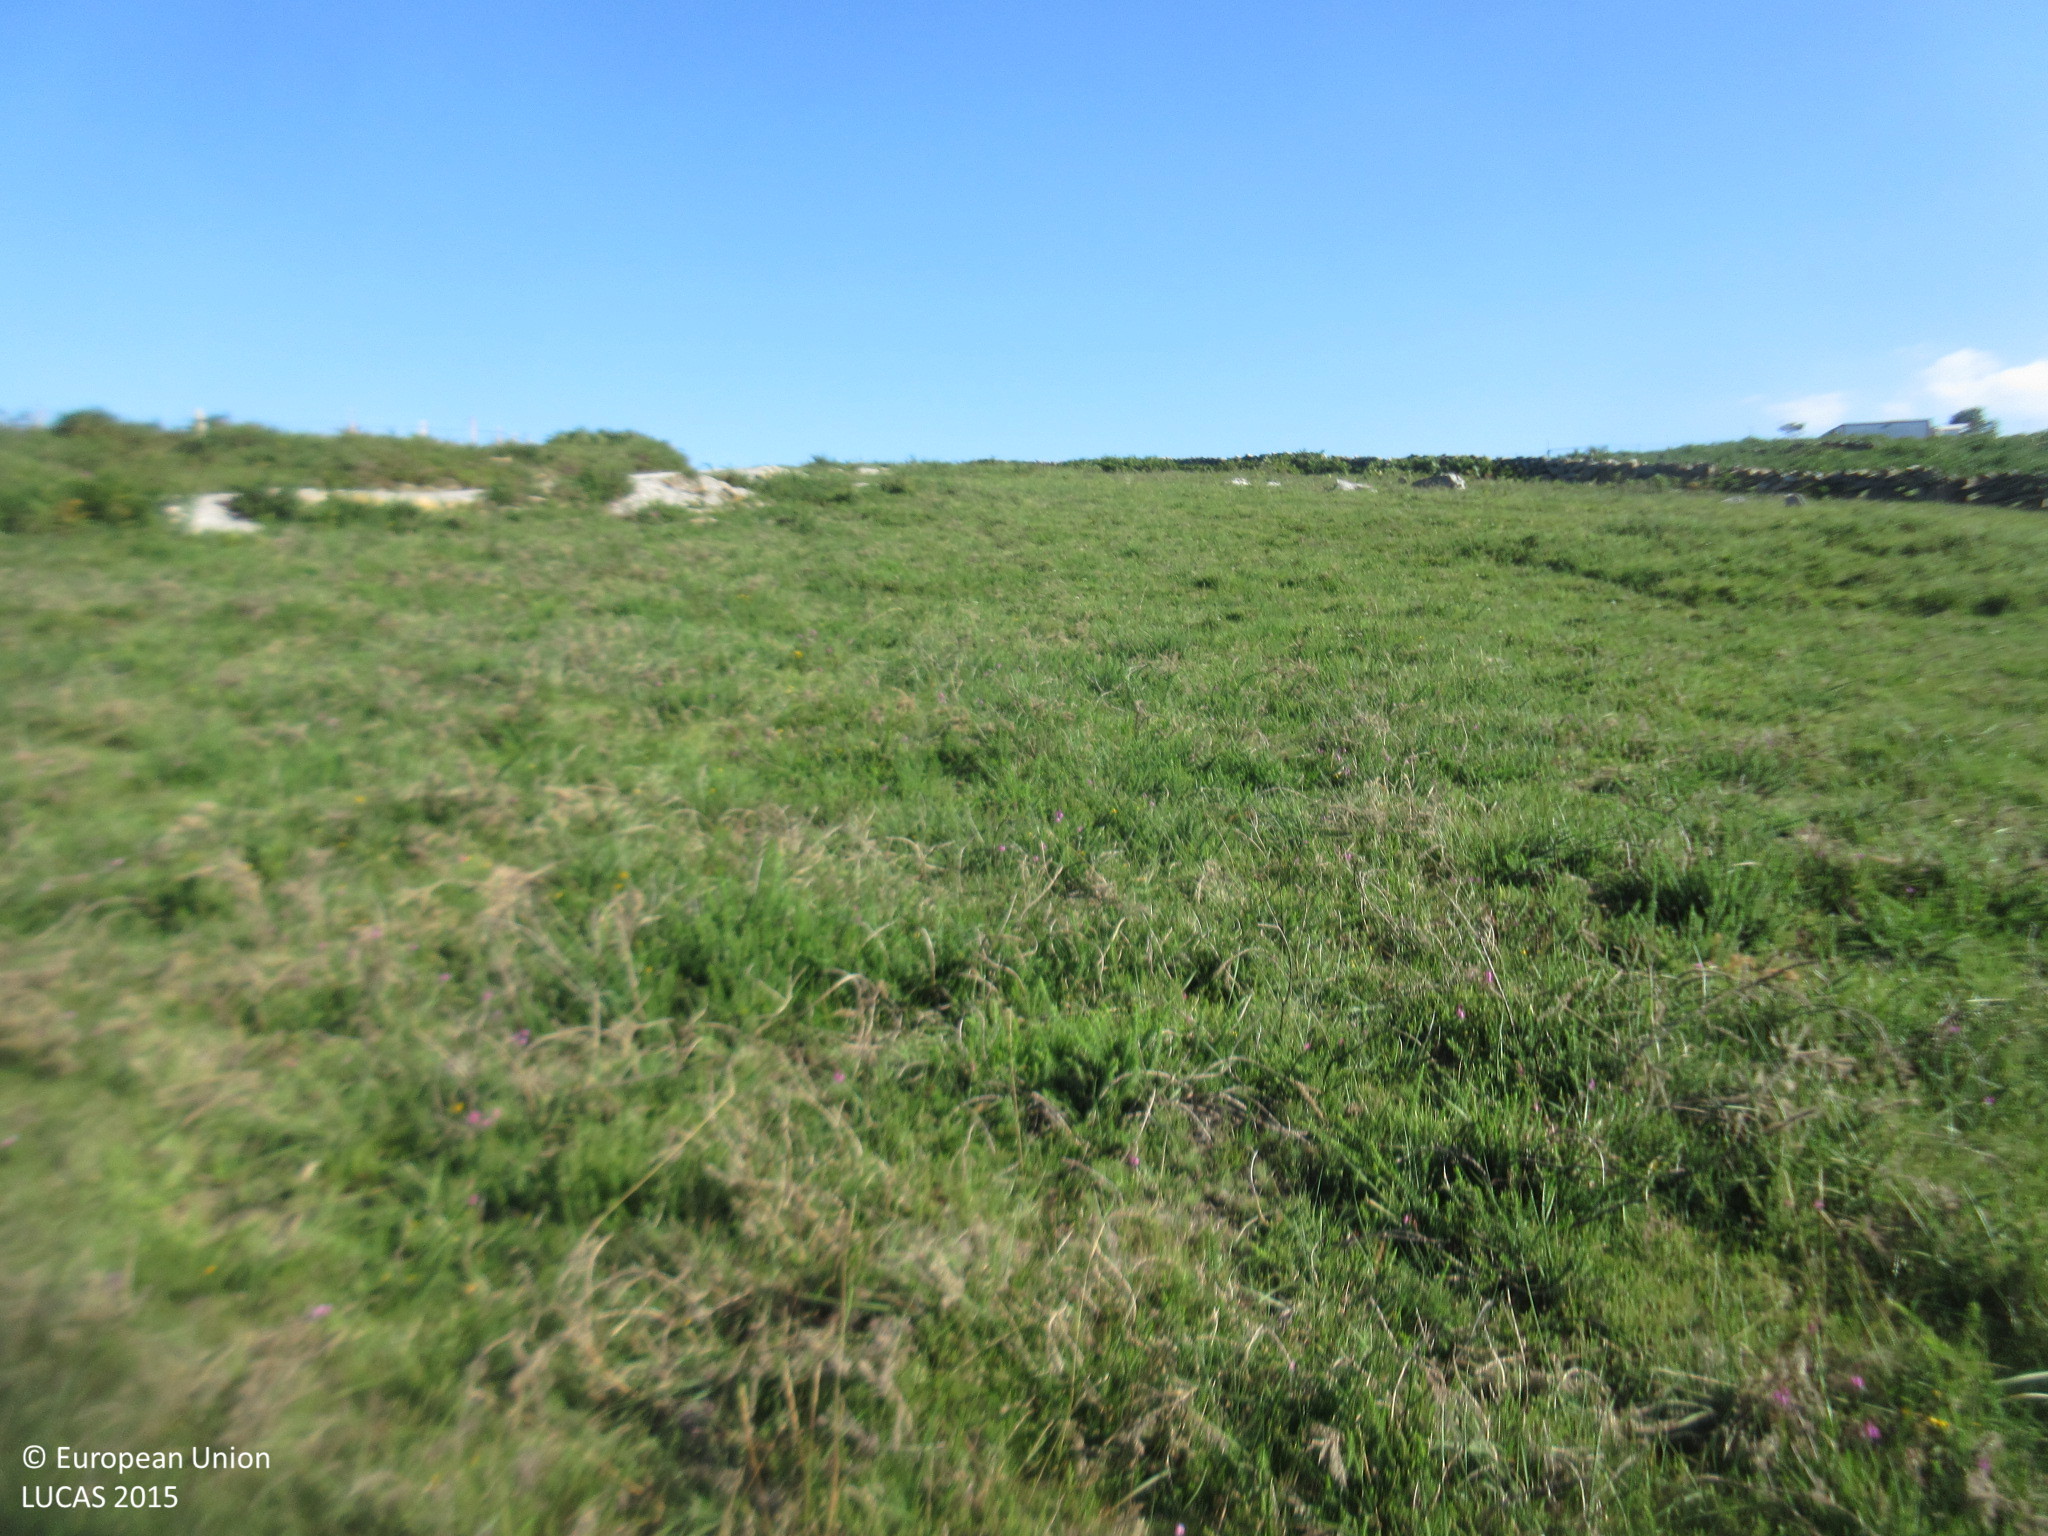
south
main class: Shrubland
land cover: Shrubland without tree cover
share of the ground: > 75 %
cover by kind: shrubs 100 %
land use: Agriculture (excluding fallow land and kitchen gardens)
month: July
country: ES
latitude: 43.1318
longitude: -3.9268
